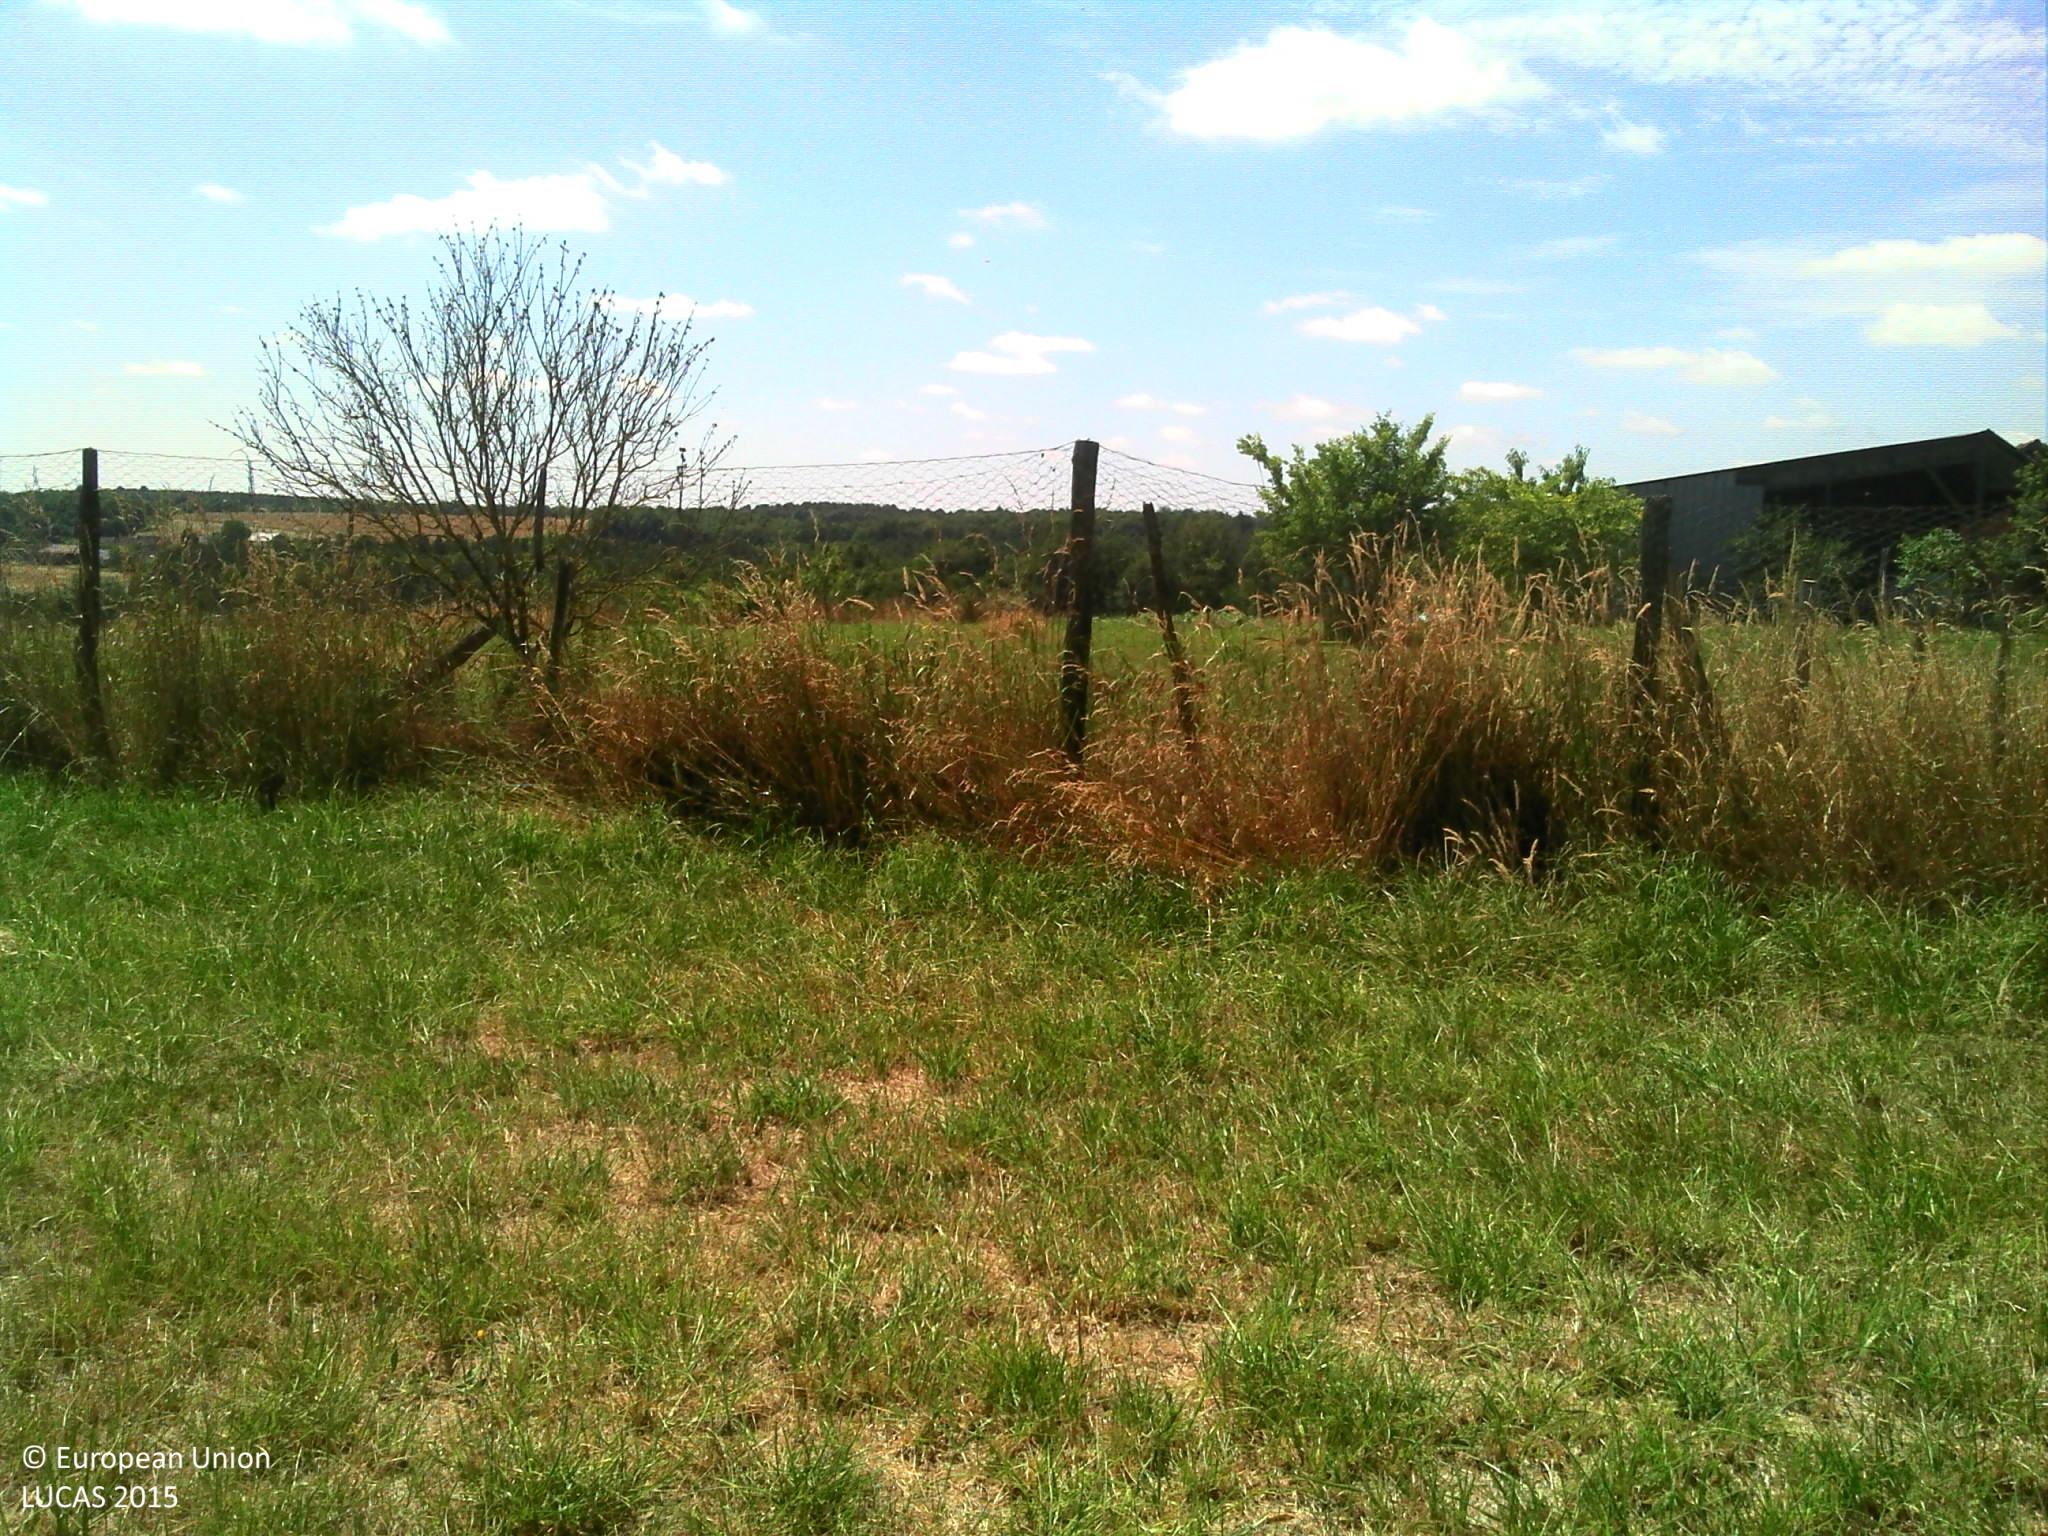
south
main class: Grassland
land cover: Grassland without tree/shrub cover
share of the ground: > 75 %
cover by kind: herbaceous plants 100 %
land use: Agriculture (excluding fallow land and kitchen gardens)
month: July
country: FR
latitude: 46.8858
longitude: 0.8896
